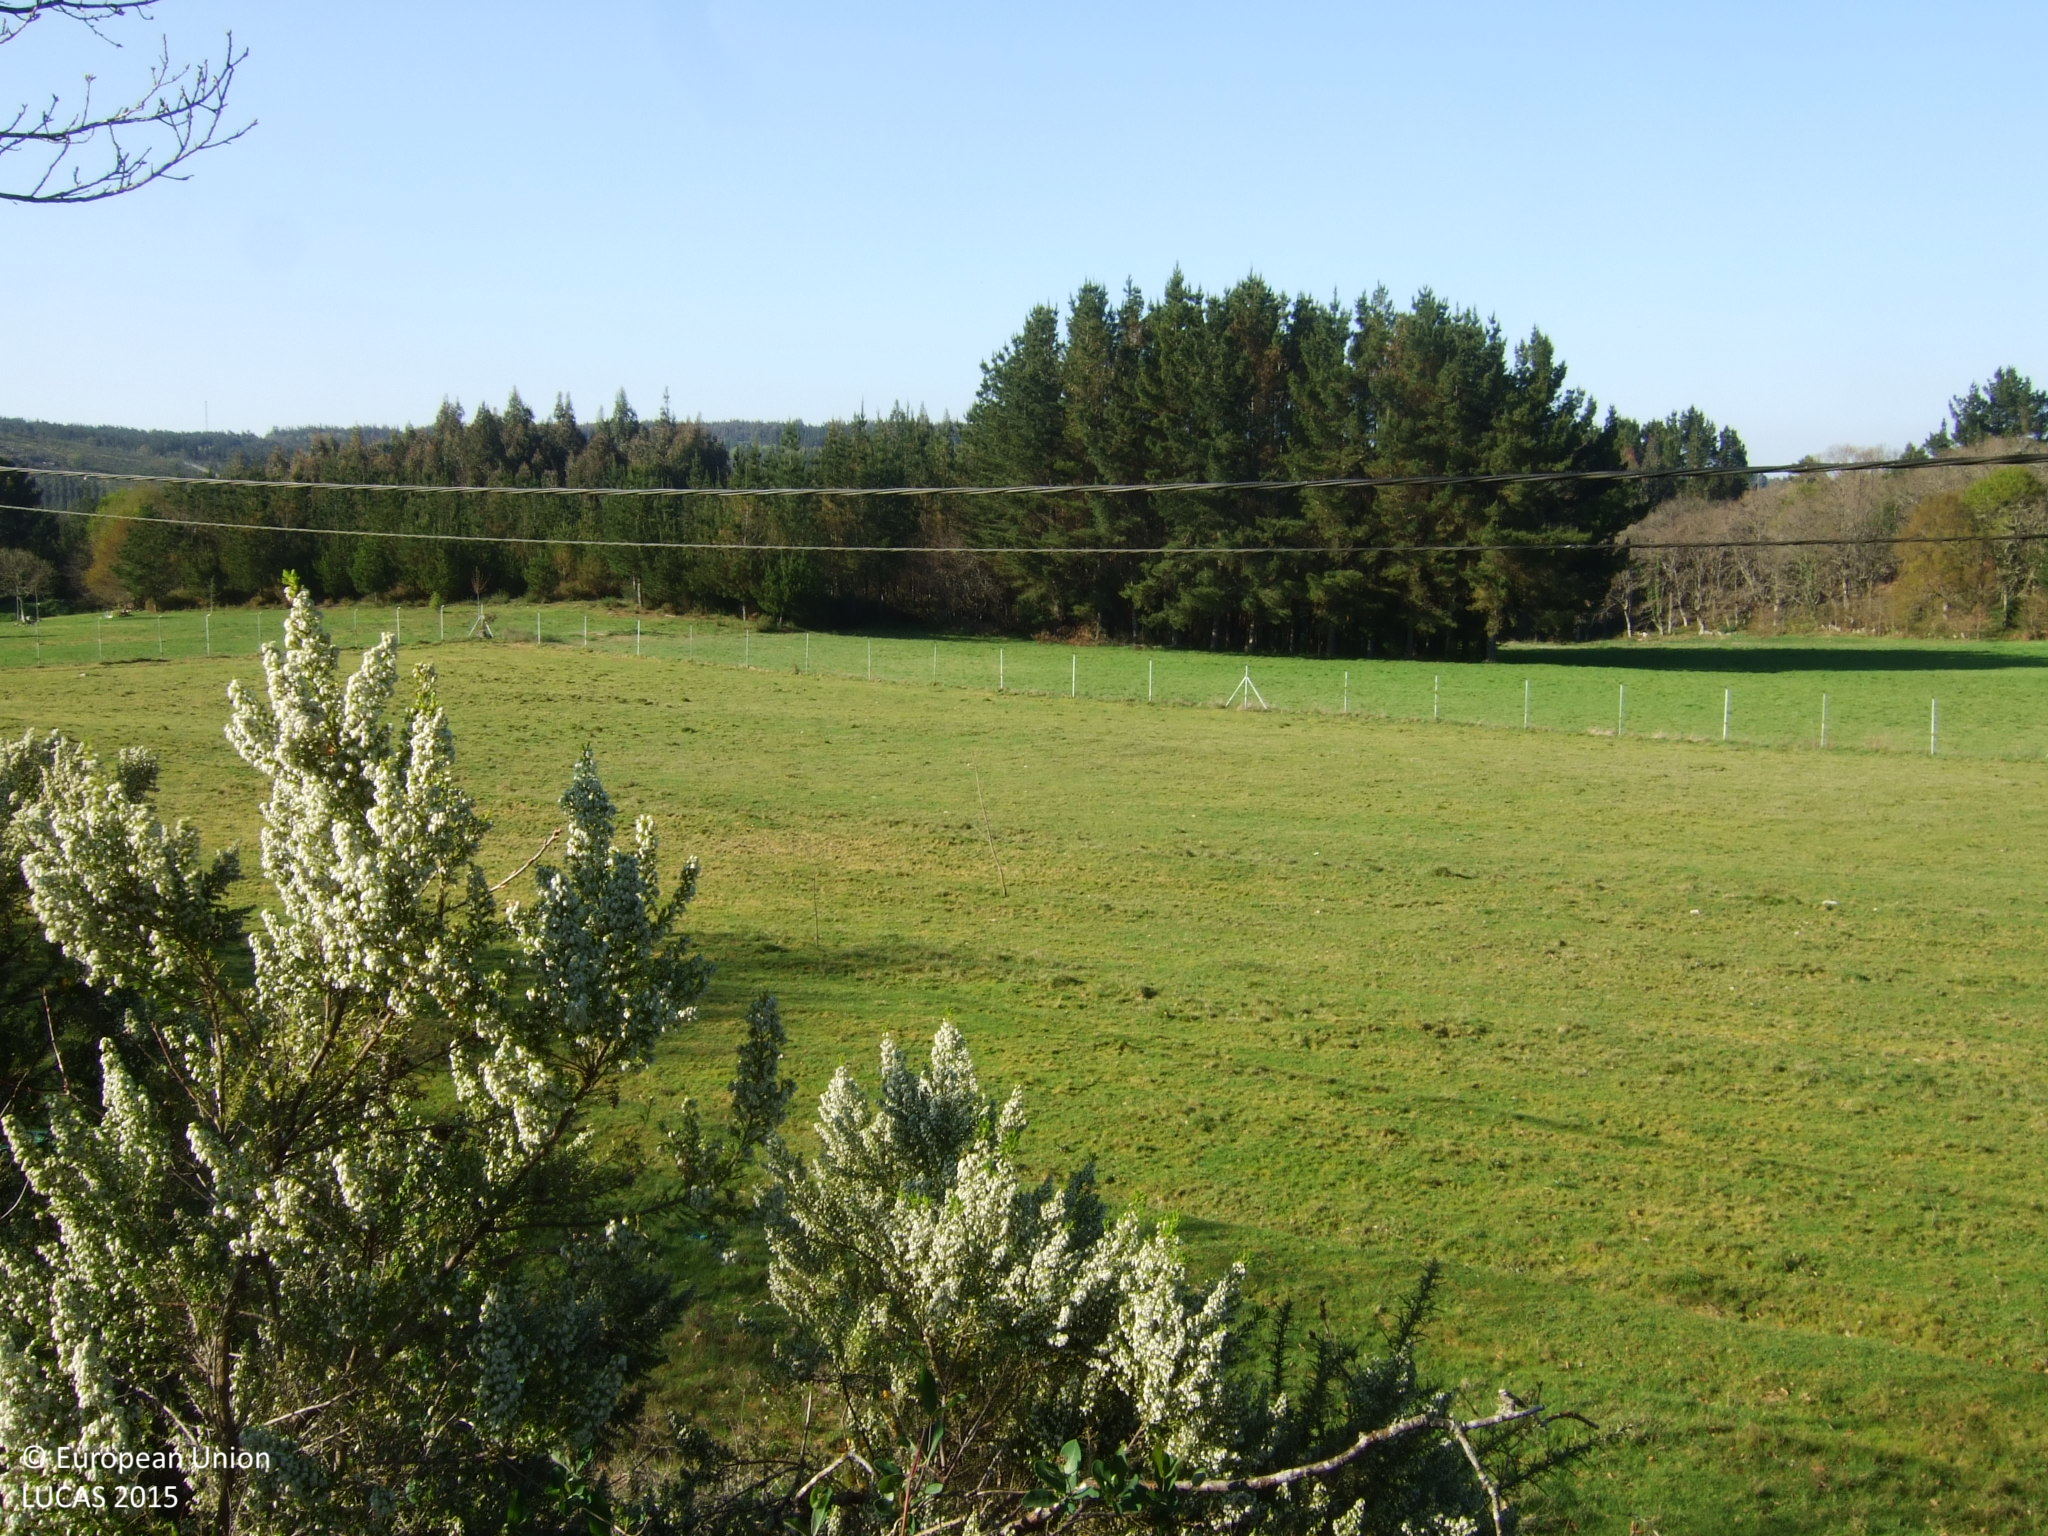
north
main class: Grassland
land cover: Grassland without tree/shrub cover
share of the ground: > 75 %
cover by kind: herbaceous plants 100 %
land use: Agriculture (excluding fallow land and kitchen gardens)
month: April
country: ES
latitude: 43.0621
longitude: -7.6520
